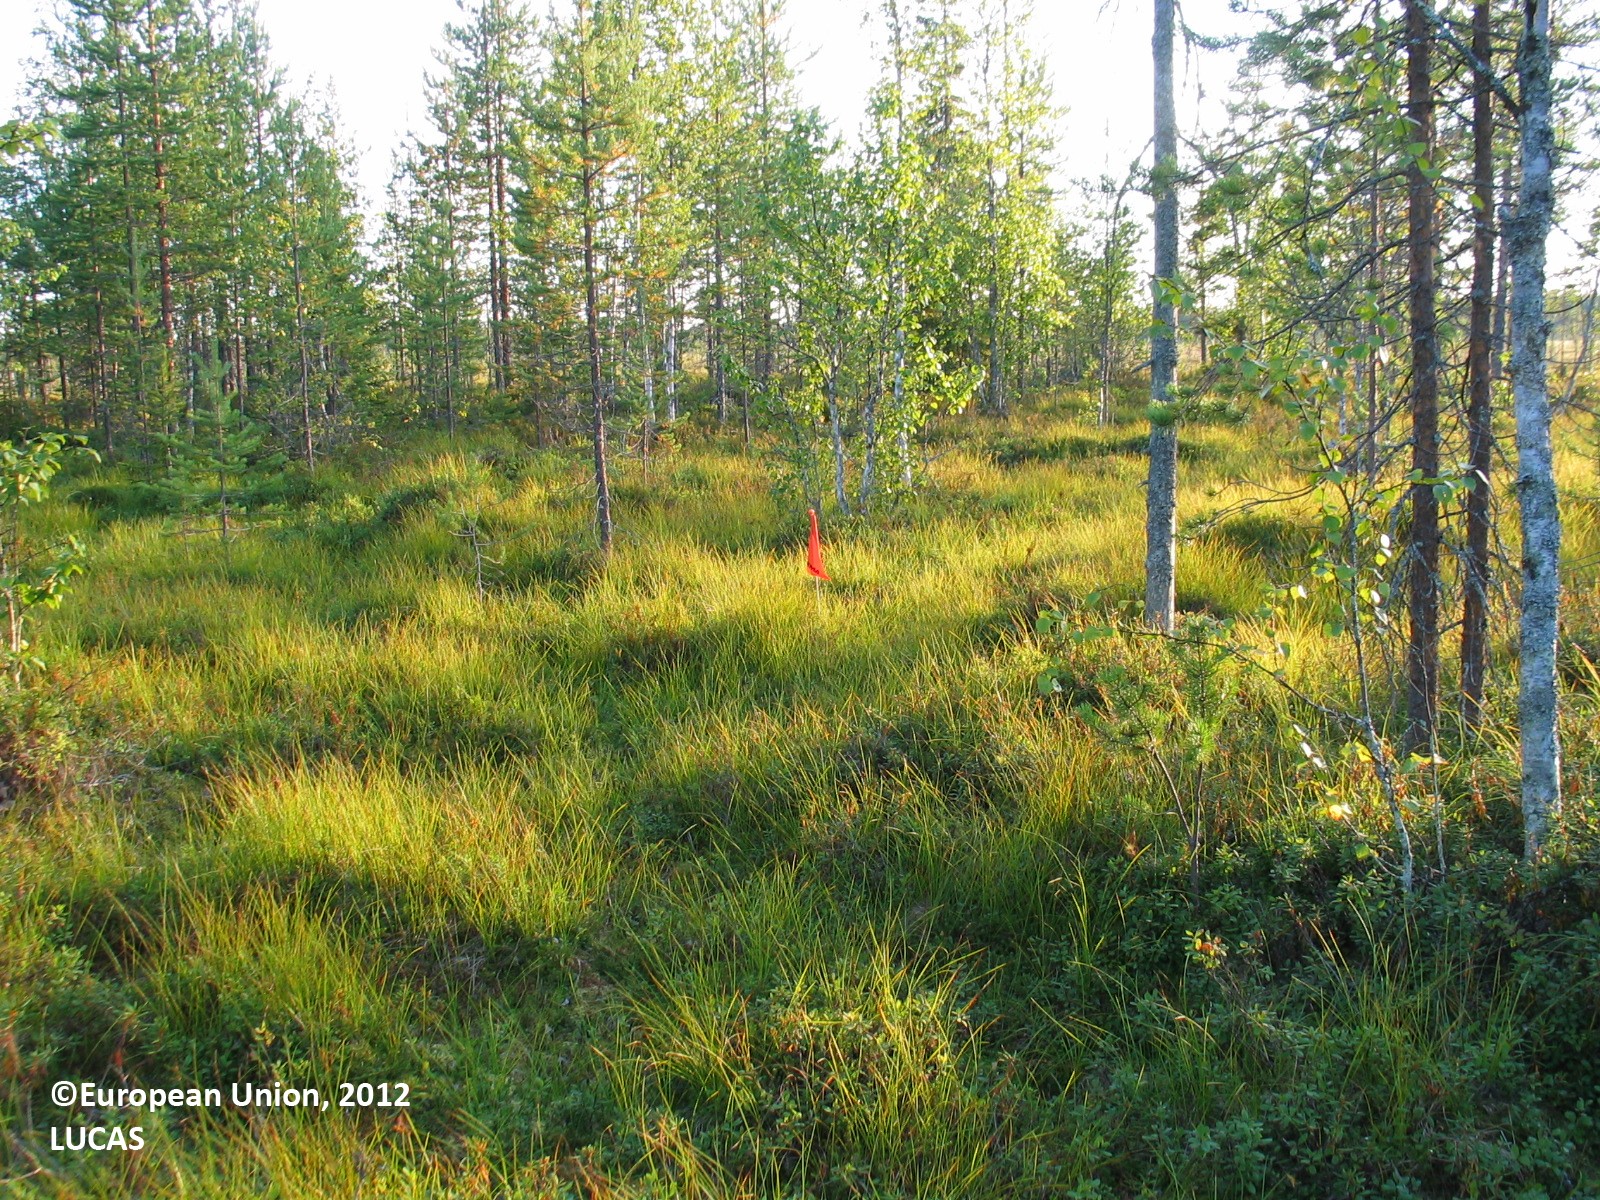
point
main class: Woodland
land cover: Pine dominated mixed woodland
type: mire and swamp forests
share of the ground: 10 - 25 %
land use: Forestry
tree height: > 5 m
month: August
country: FI
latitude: 65.6506
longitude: 25.8421
